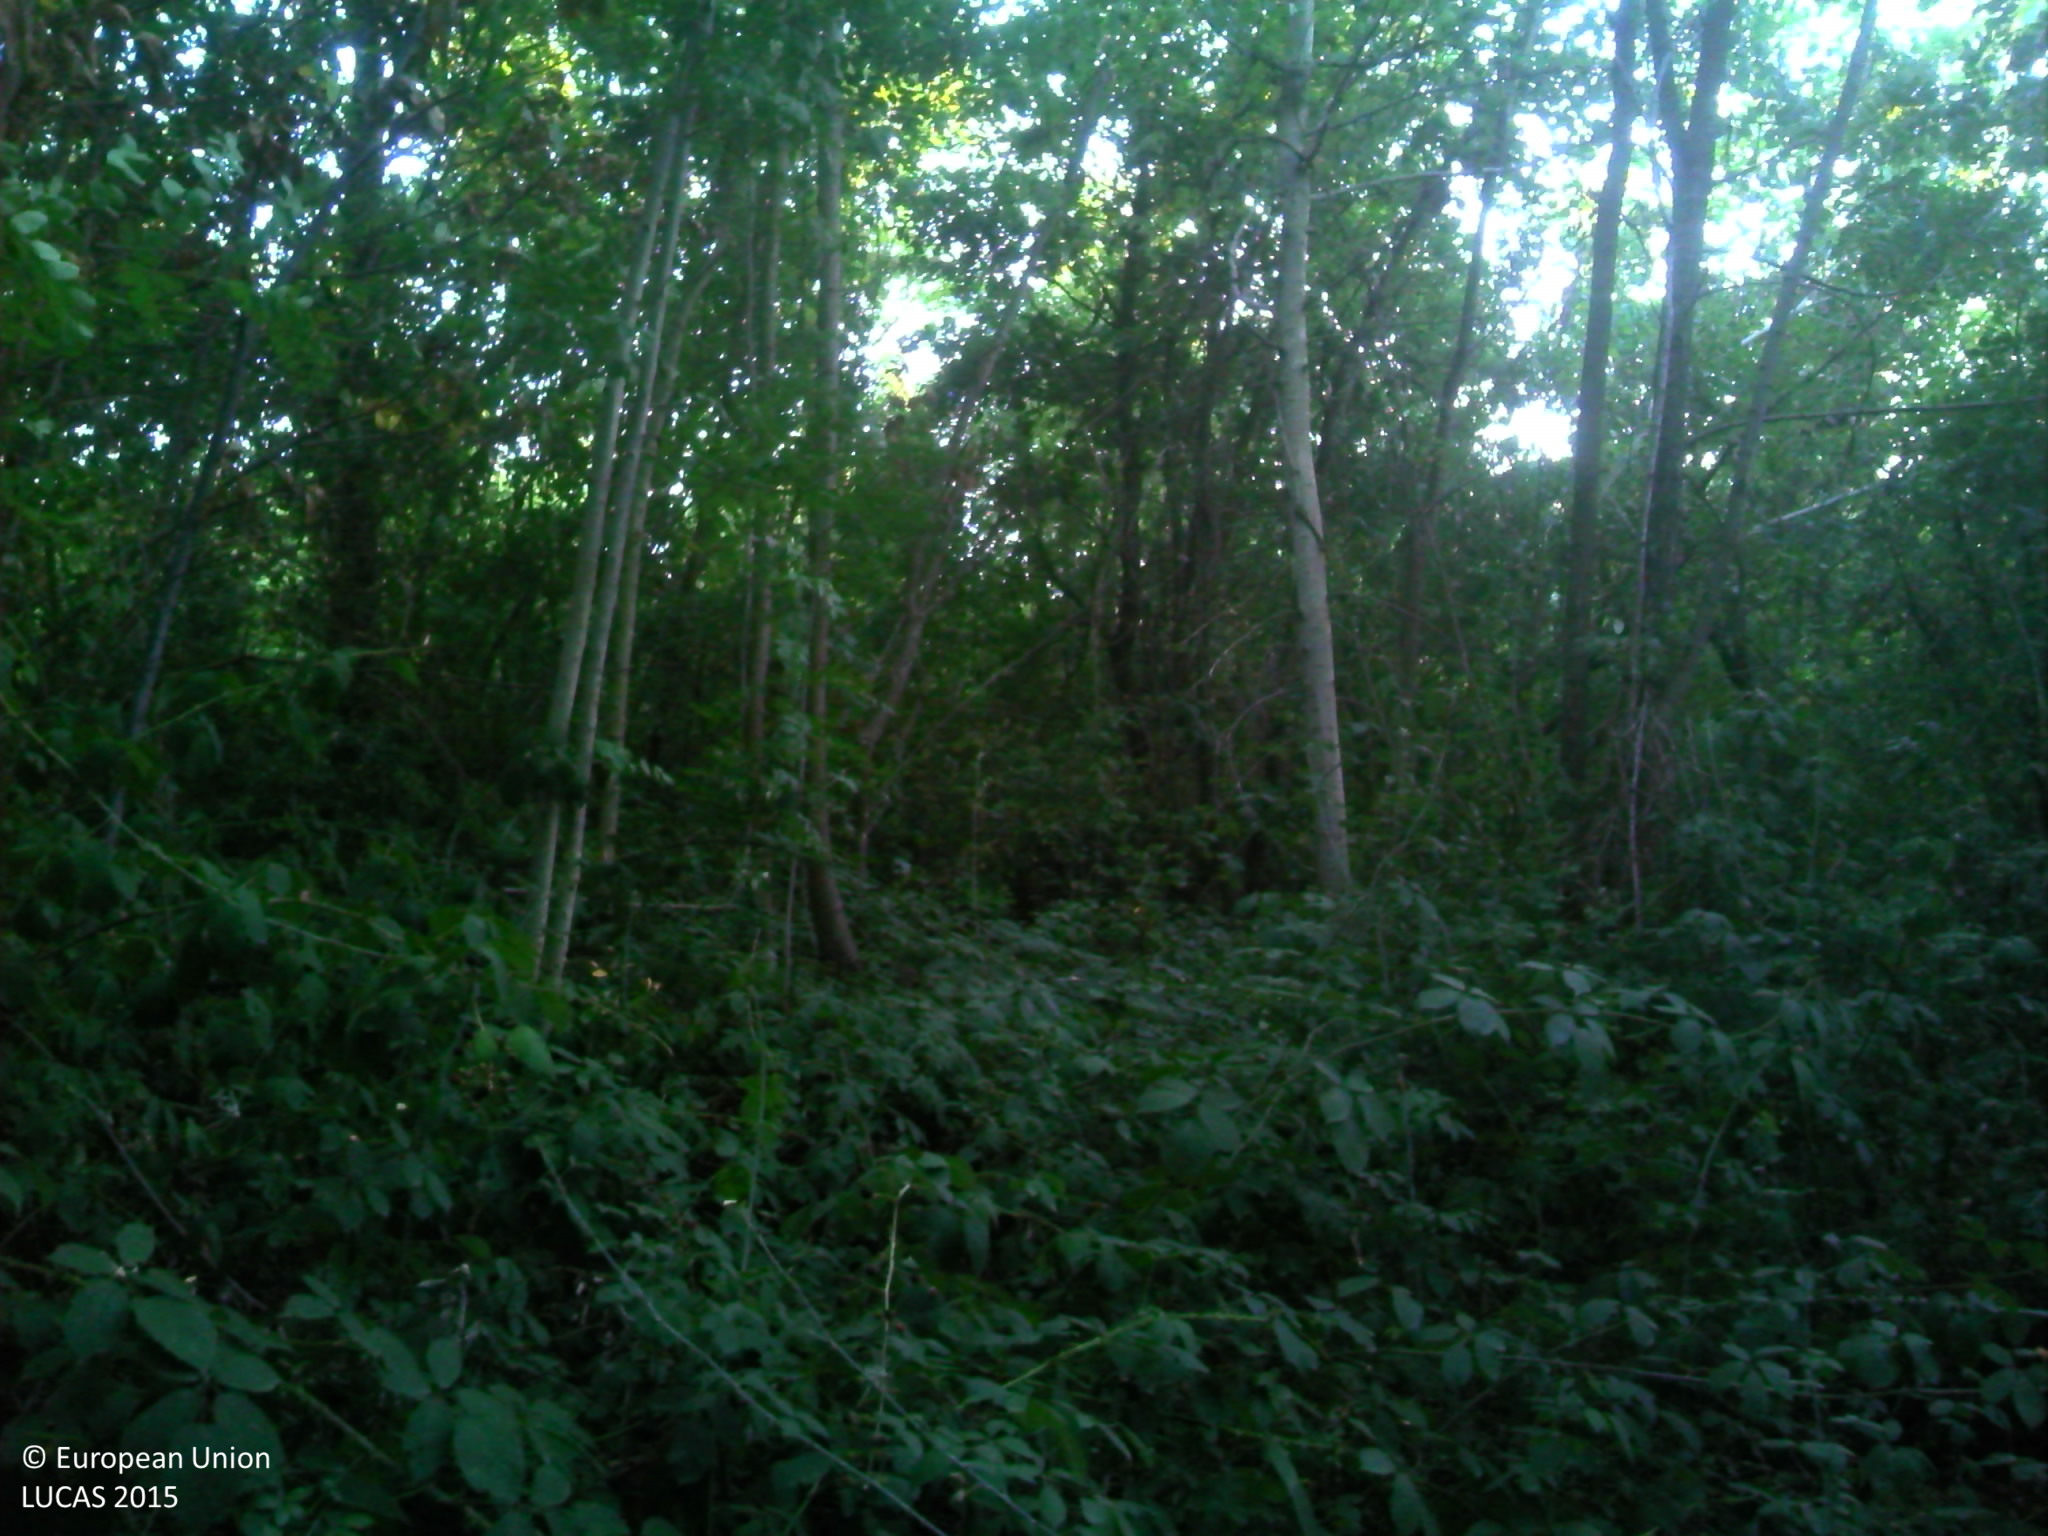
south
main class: Woodland
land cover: Broadleaved woodland
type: mesophytic deciduous forest
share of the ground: > 75 %
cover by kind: broadleaved forest trees 80 %, herbaceous plants 20 %
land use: Forestry
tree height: > 5 m
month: September
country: FR
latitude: 45.2067
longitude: 5.0270
